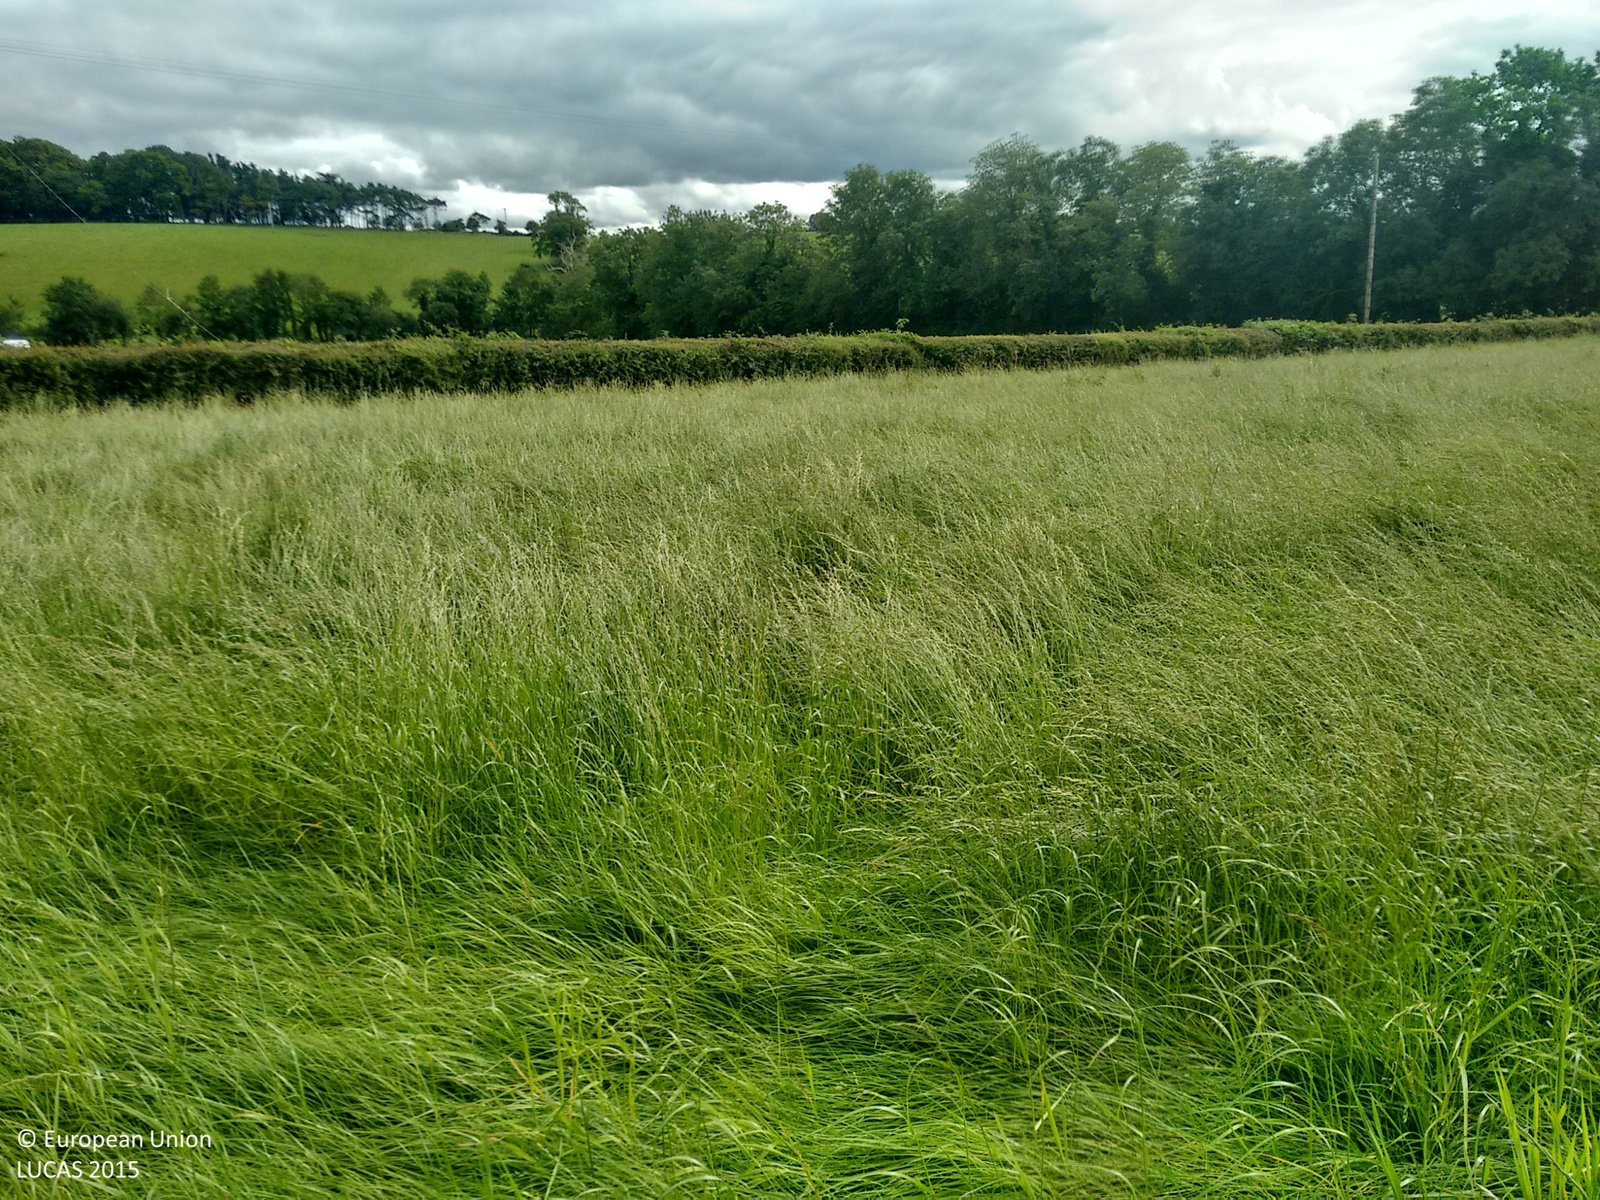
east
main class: Grassland
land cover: Grassland without tree/shrub cover
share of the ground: > 75 %
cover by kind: herbaceous plants 100 %
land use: Agriculture (excluding fallow land and kitchen gardens)
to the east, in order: Grassland without tree/shrub cover; Managed hedges; Grassland without tree/shrub cover; Managed hedges; Grass margins; Paved roads, cycling and walking lanes; Electric lines; Grass margins; Managed hedges; Grassland without tree/shrub cover; Ditches and canals; Grass margins; Abandoned hedges; Fences; Ditches and canals; Grassland without tree/shrub cover; Abandoned hedges; Grassland without tree/shrub cover
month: August
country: GB
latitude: 54.3114
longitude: -6.8114
